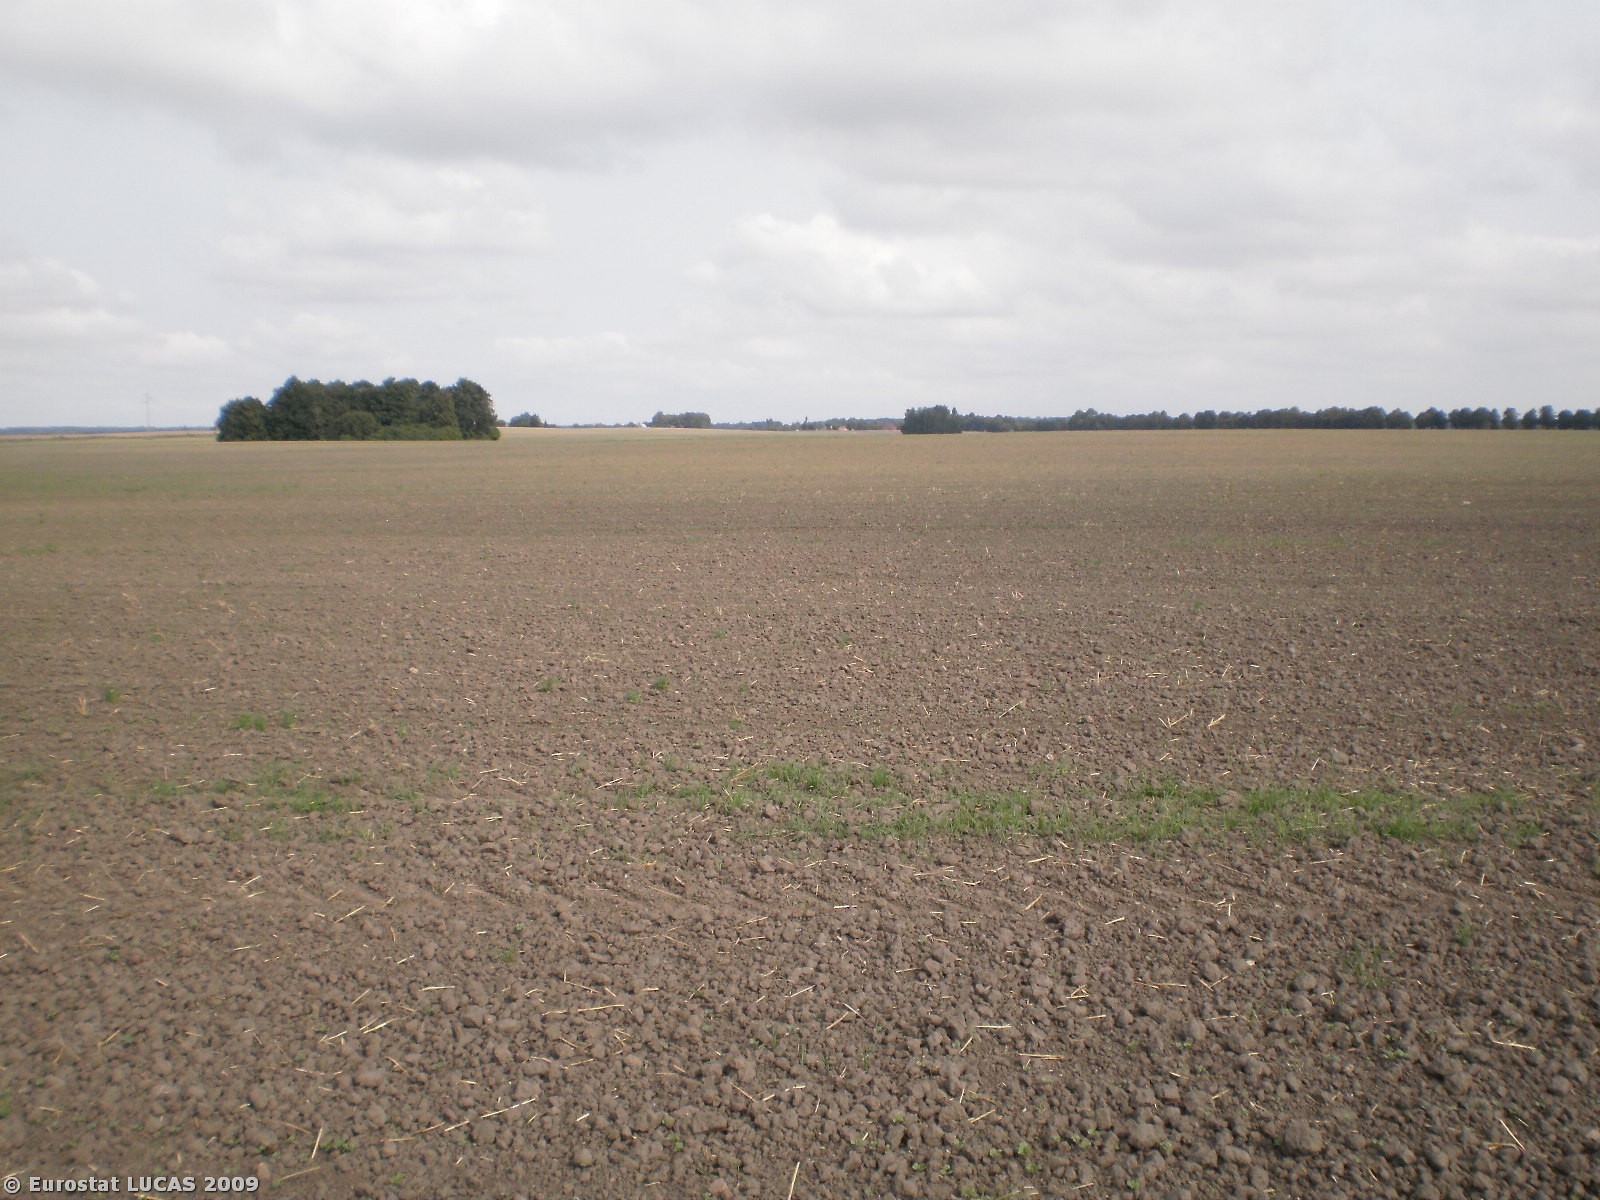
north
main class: Cropland
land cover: Common wheat
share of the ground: < 10 %
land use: Agriculture (excluding fallow land and kitchen gardens)
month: August
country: PL
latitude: 54.2192
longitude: 21.2565
